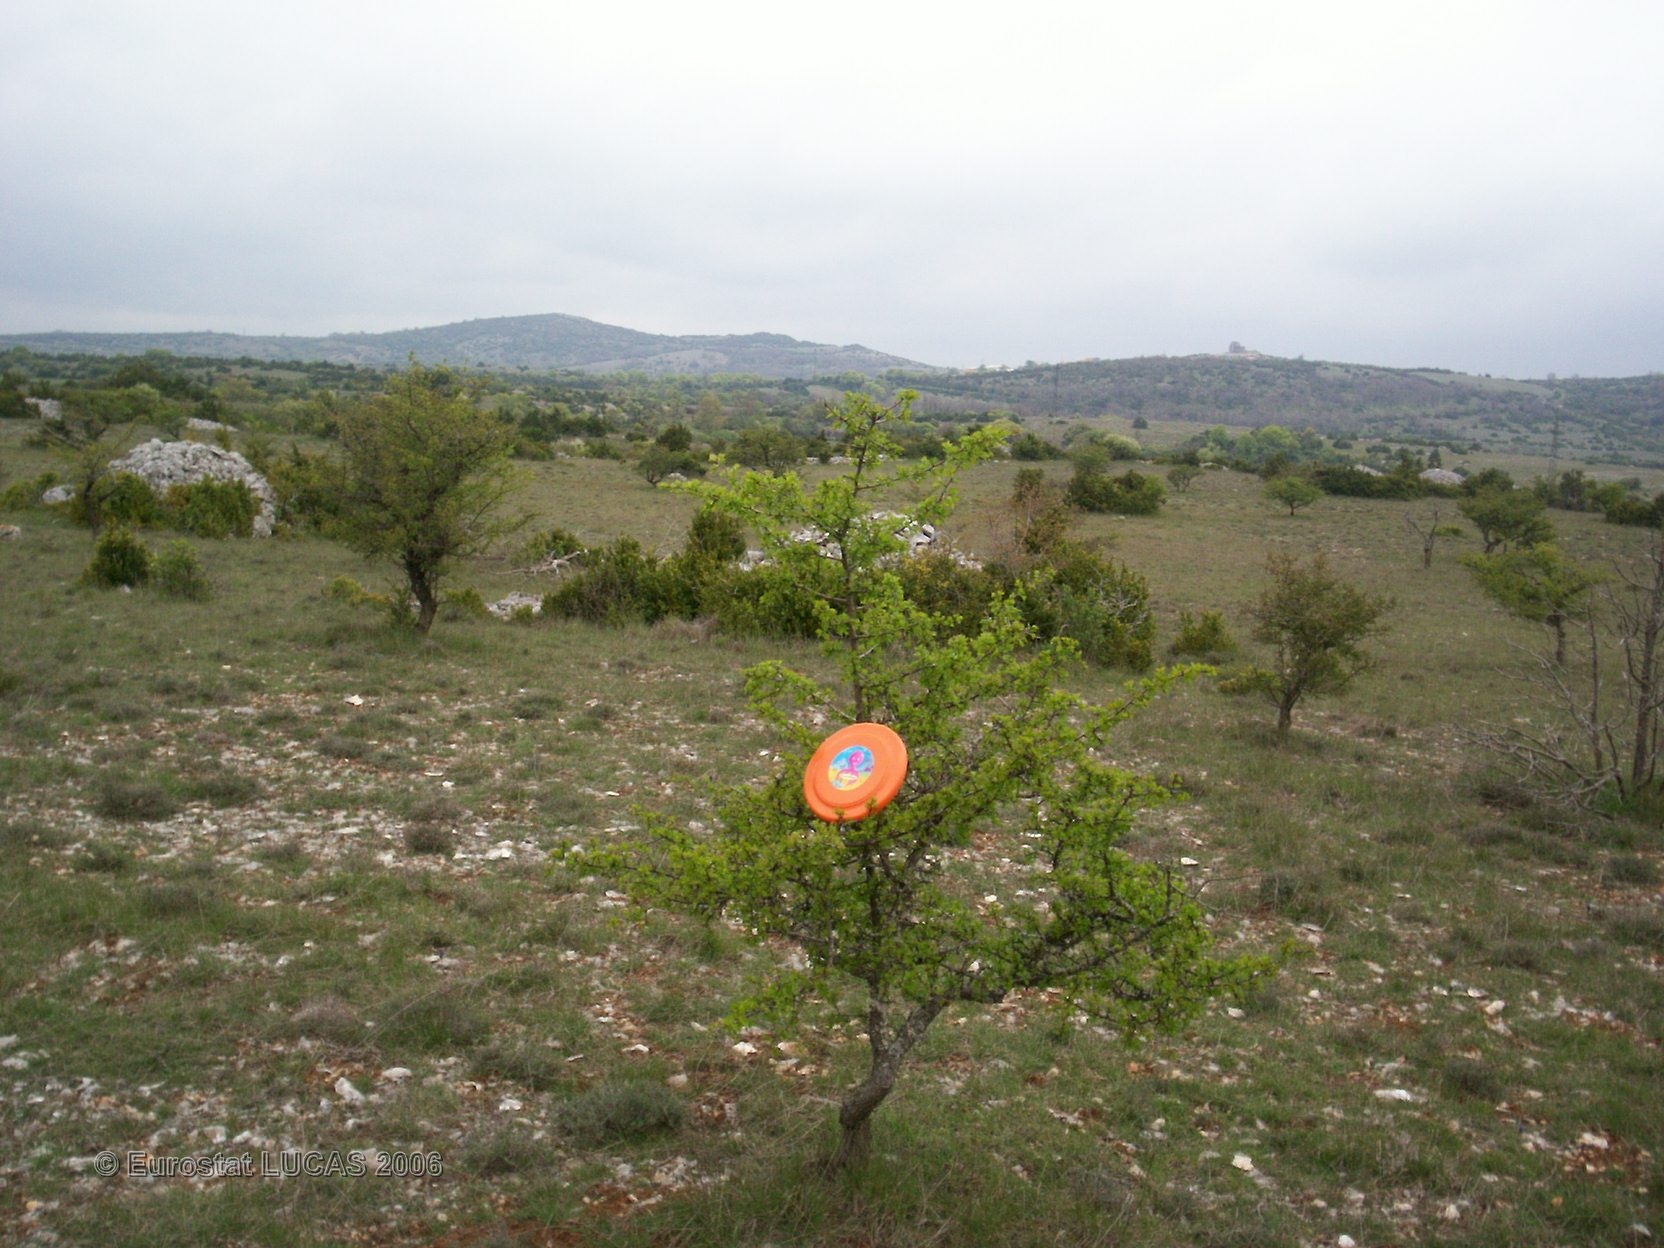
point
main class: Grassland
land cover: Grassland with sparse tree/shrub cover
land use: Agriculture (excluding fallow land and kitchen gardens)
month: May
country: FR
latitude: 43.8510
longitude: 3.4021
